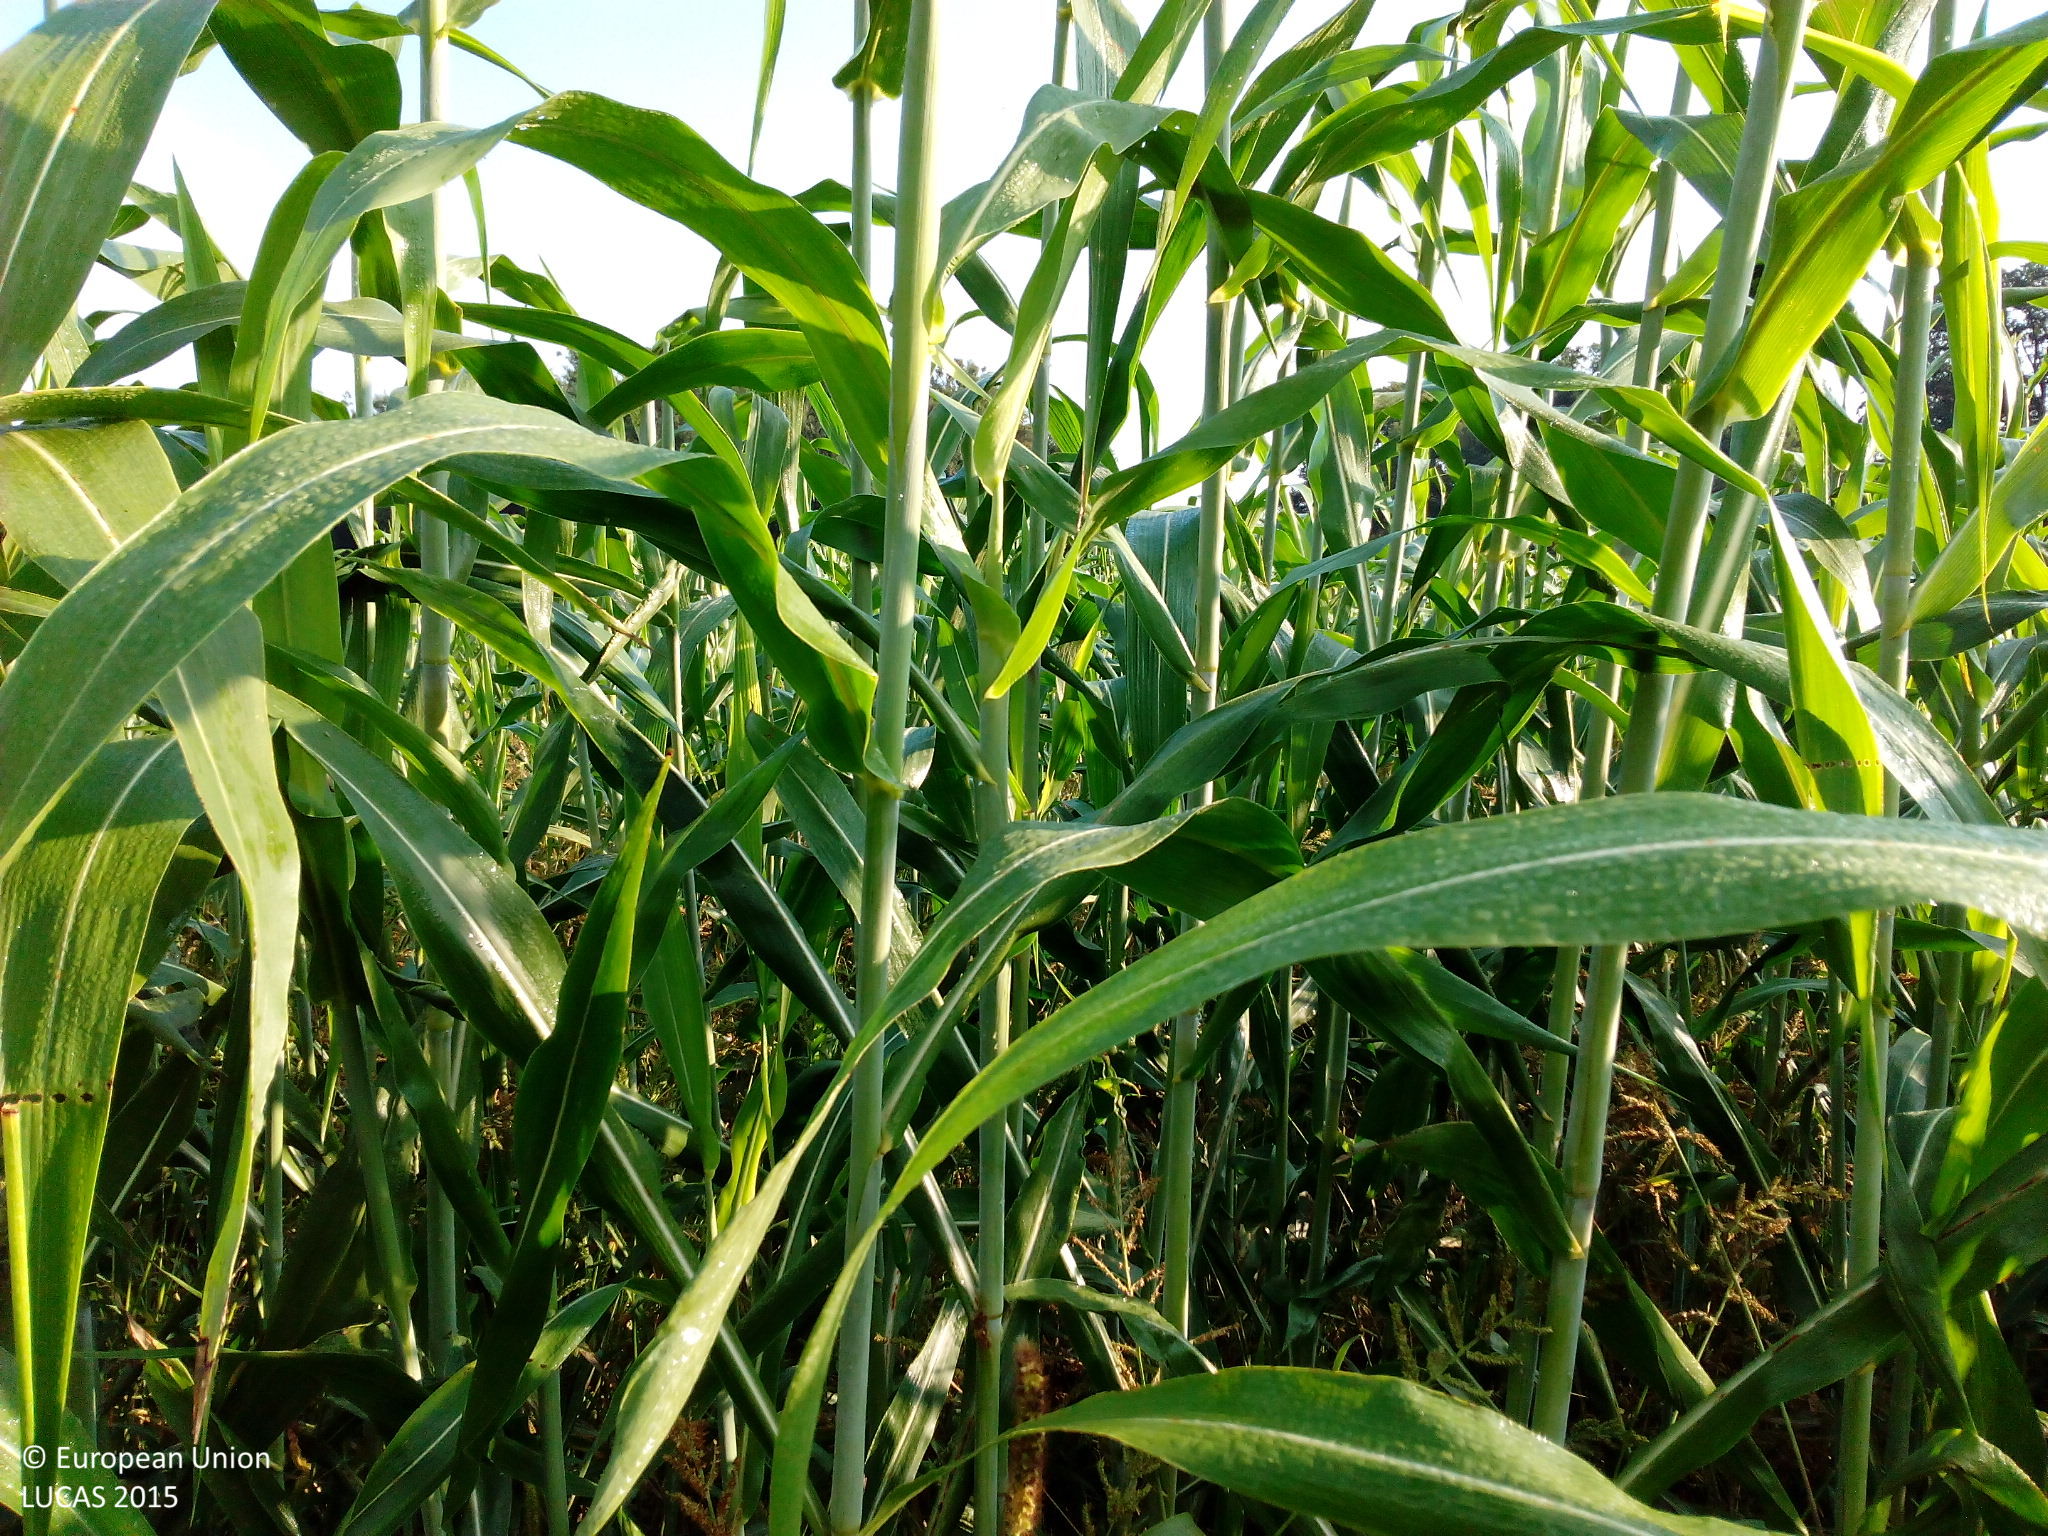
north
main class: Cropland
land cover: Maize
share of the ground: > 75 %
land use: Agriculture (excluding fallow land and kitchen gardens)
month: August
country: DE
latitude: 48.4930
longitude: 10.3111
